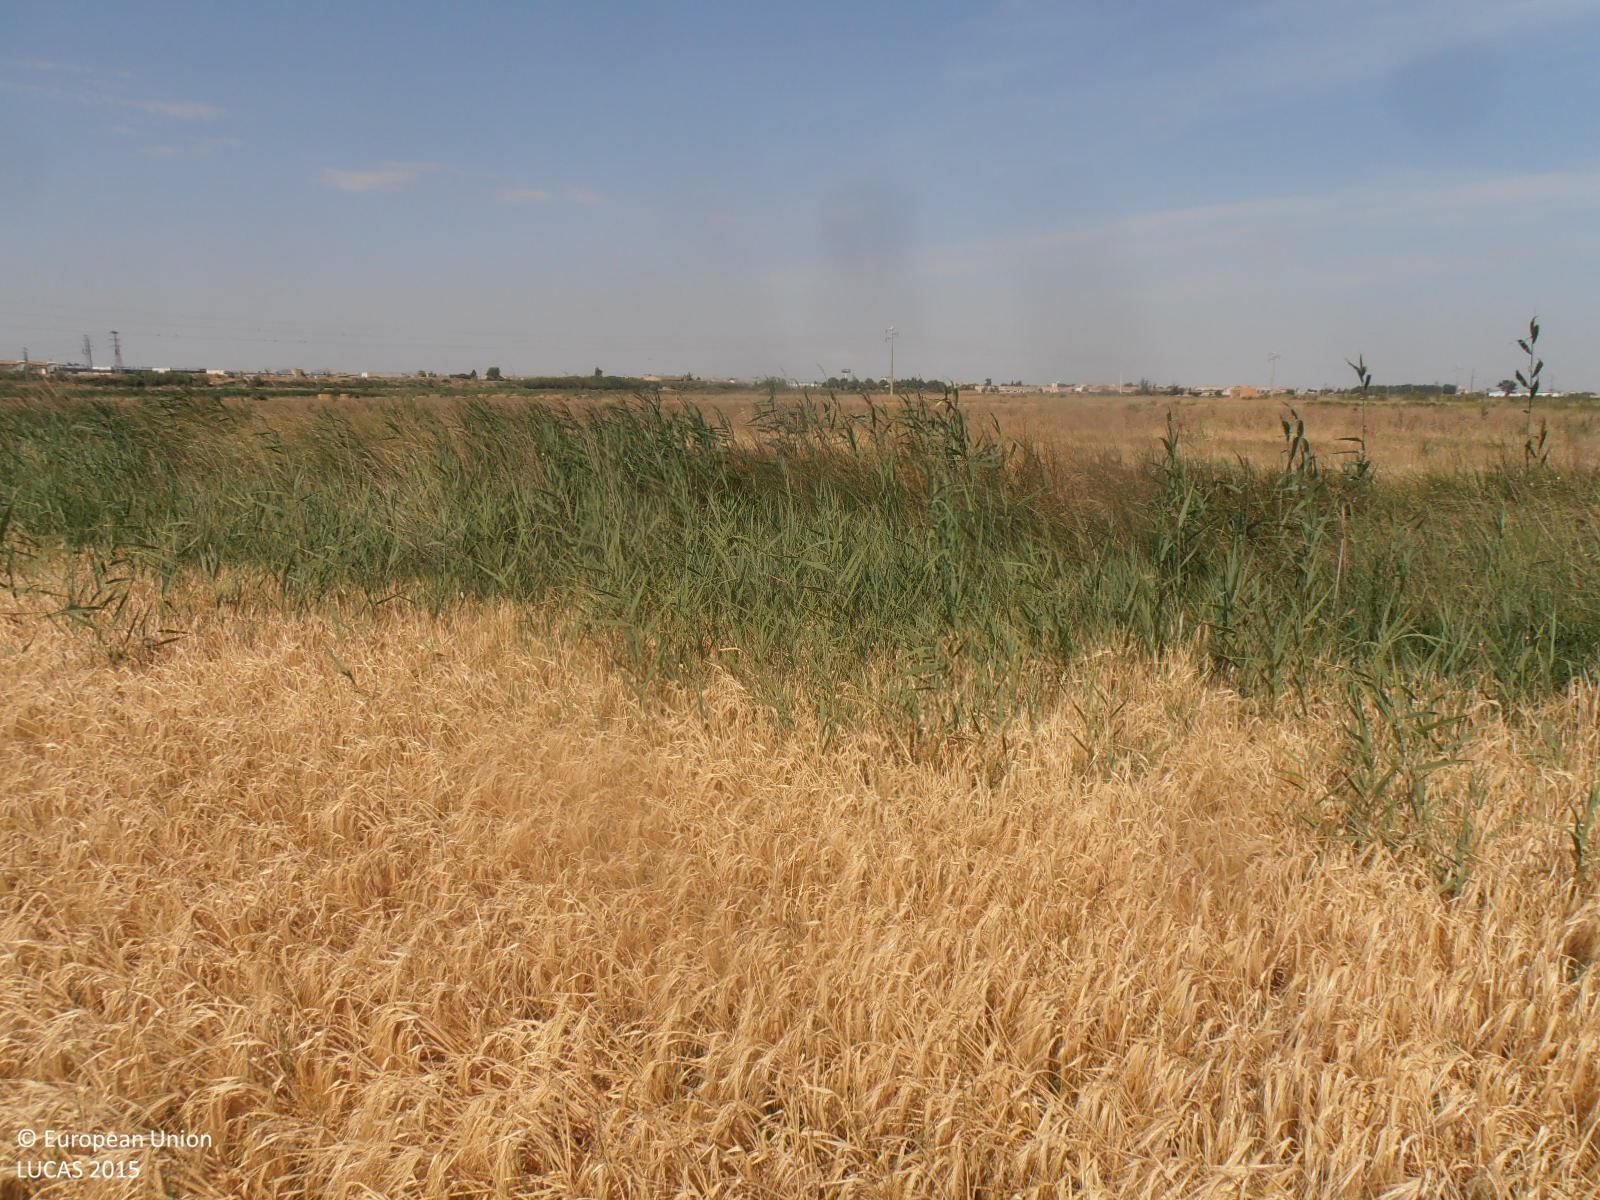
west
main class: Cropland
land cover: Barley
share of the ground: > 75 %
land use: Agriculture (excluding fallow land and kitchen gardens)
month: June
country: ES
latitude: 41.7379
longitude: -1.0495
